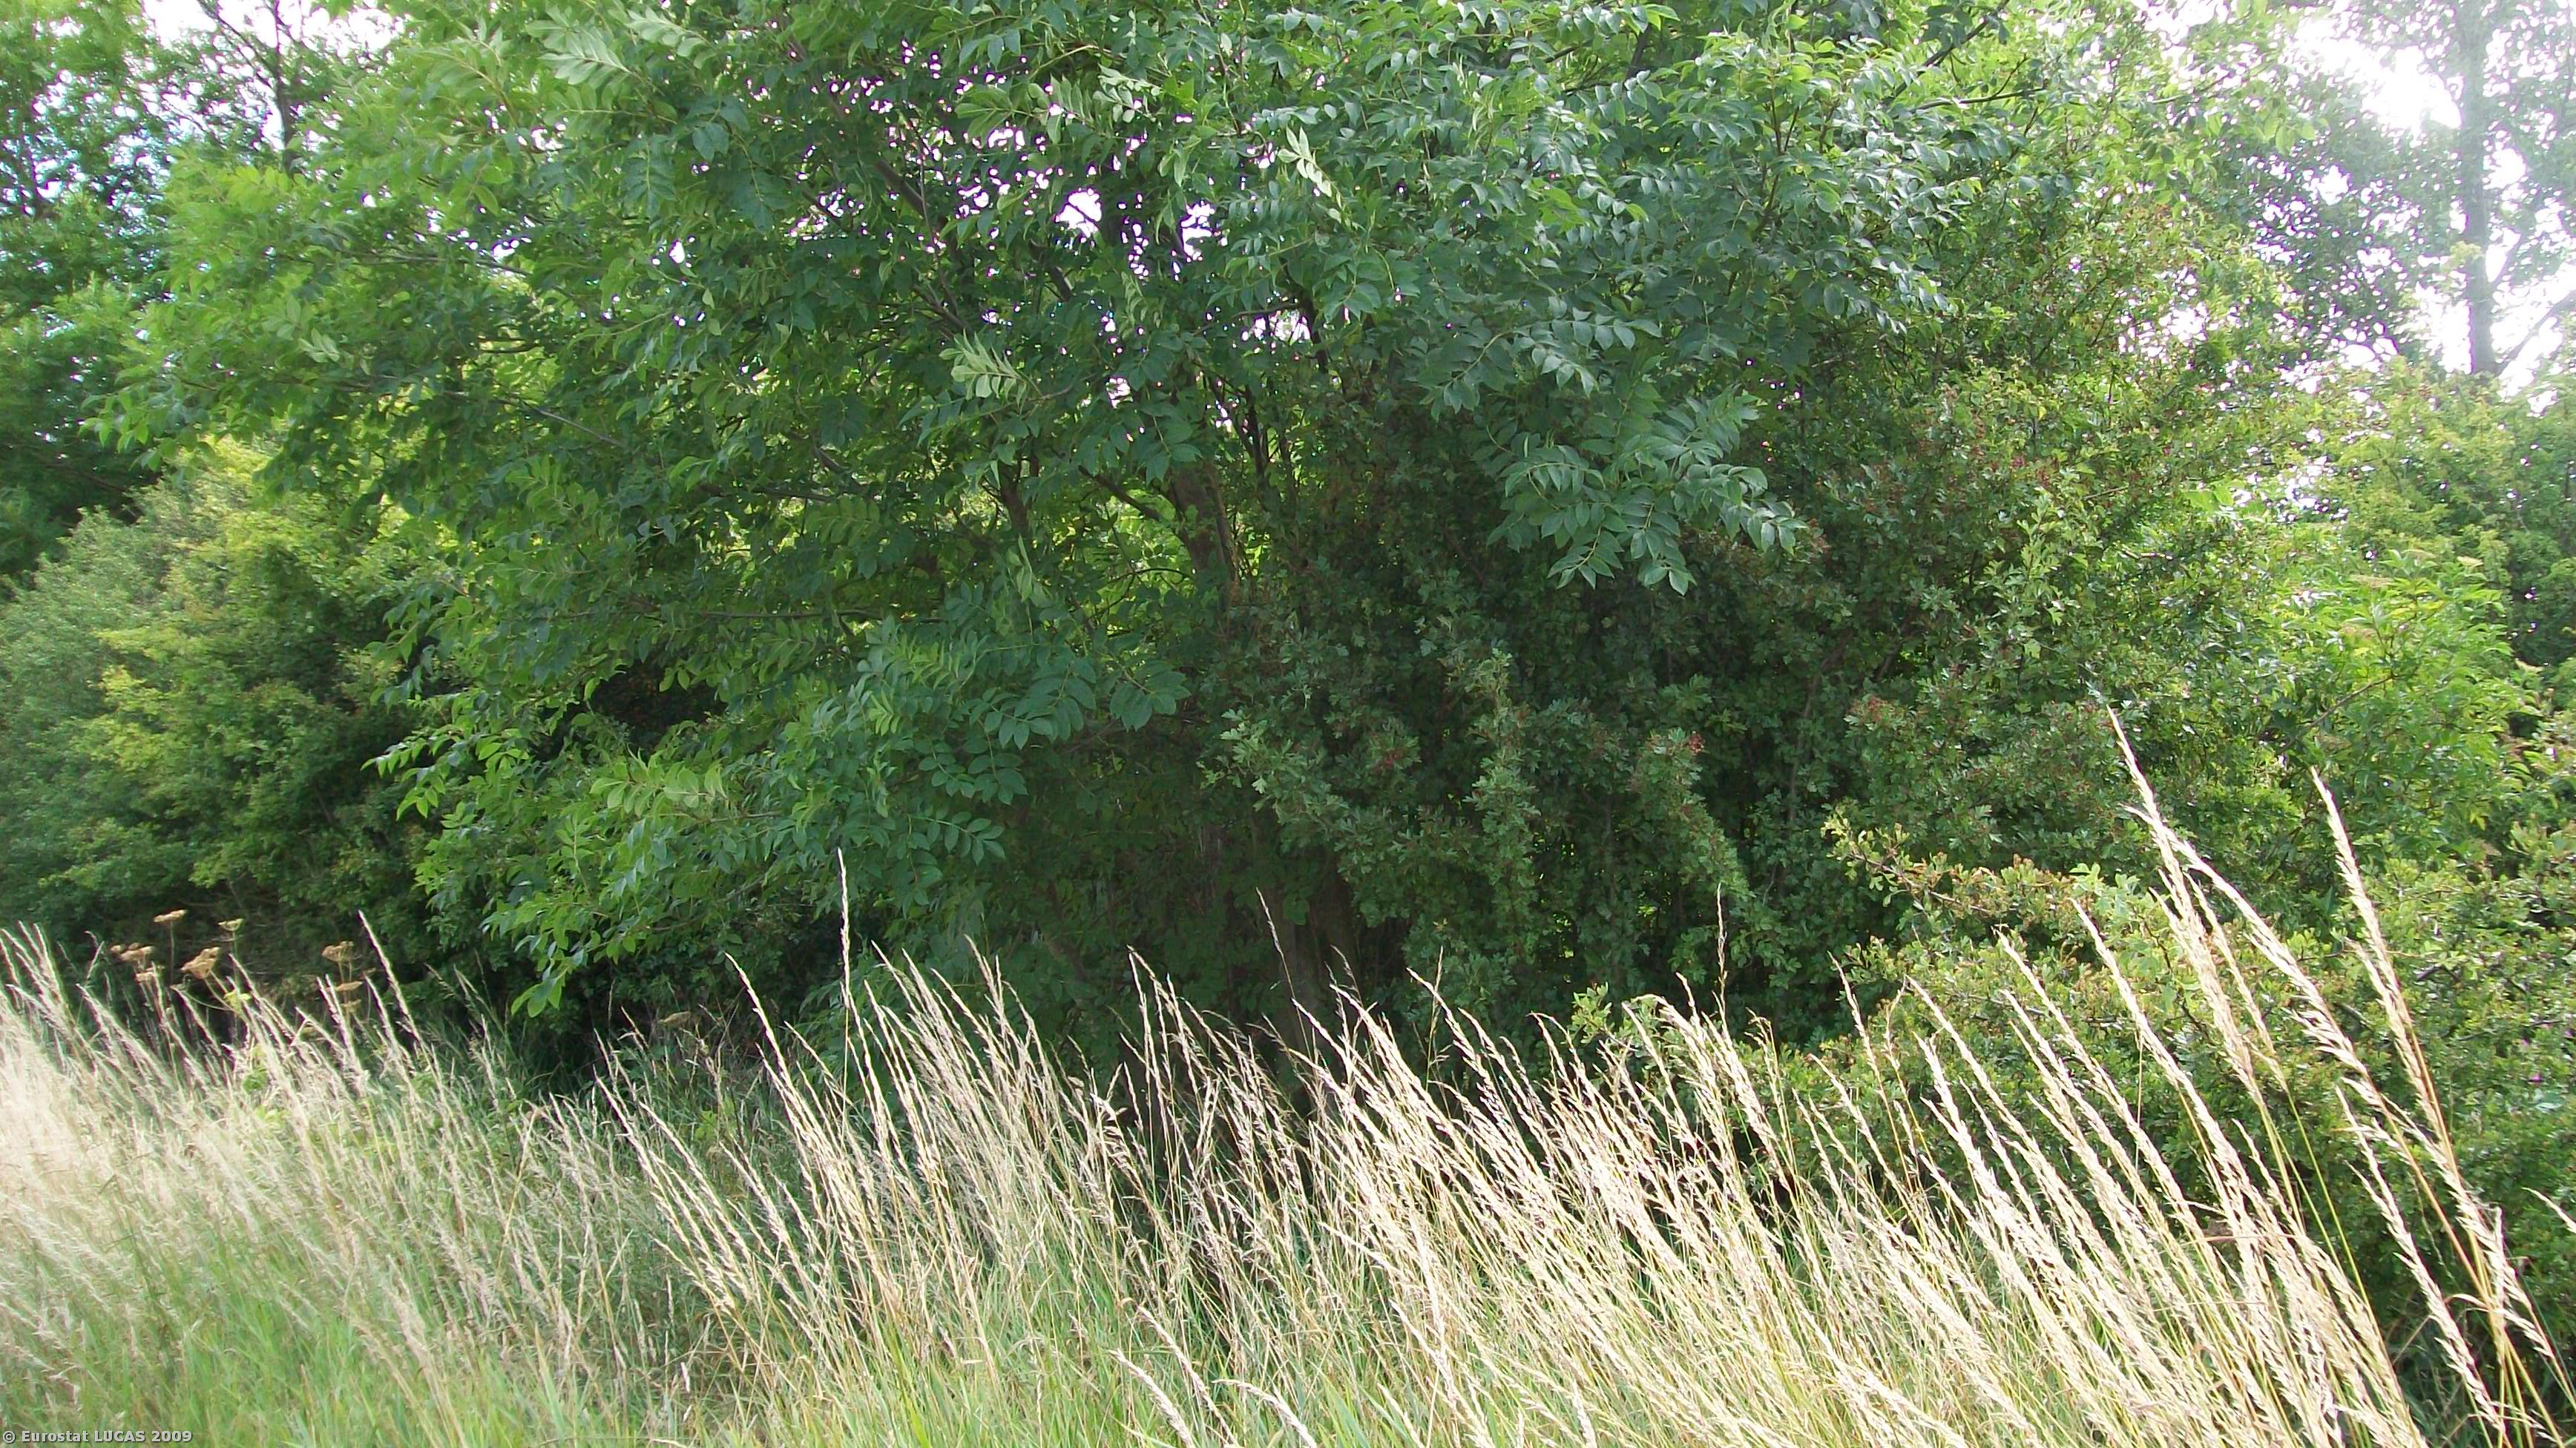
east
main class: Cropland
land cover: Common wheat
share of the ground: > 75 %
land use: Agriculture (excluding fallow land and kitchen gardens)
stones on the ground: < 10 %
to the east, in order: Common wheat; Grass margins; Broadleaved woodland; Grass margins; Tracks; Grass margins; Broadleaved woodland; Grass margins; Common wheat
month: July
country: GB
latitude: 53.8173
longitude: -0.2564
